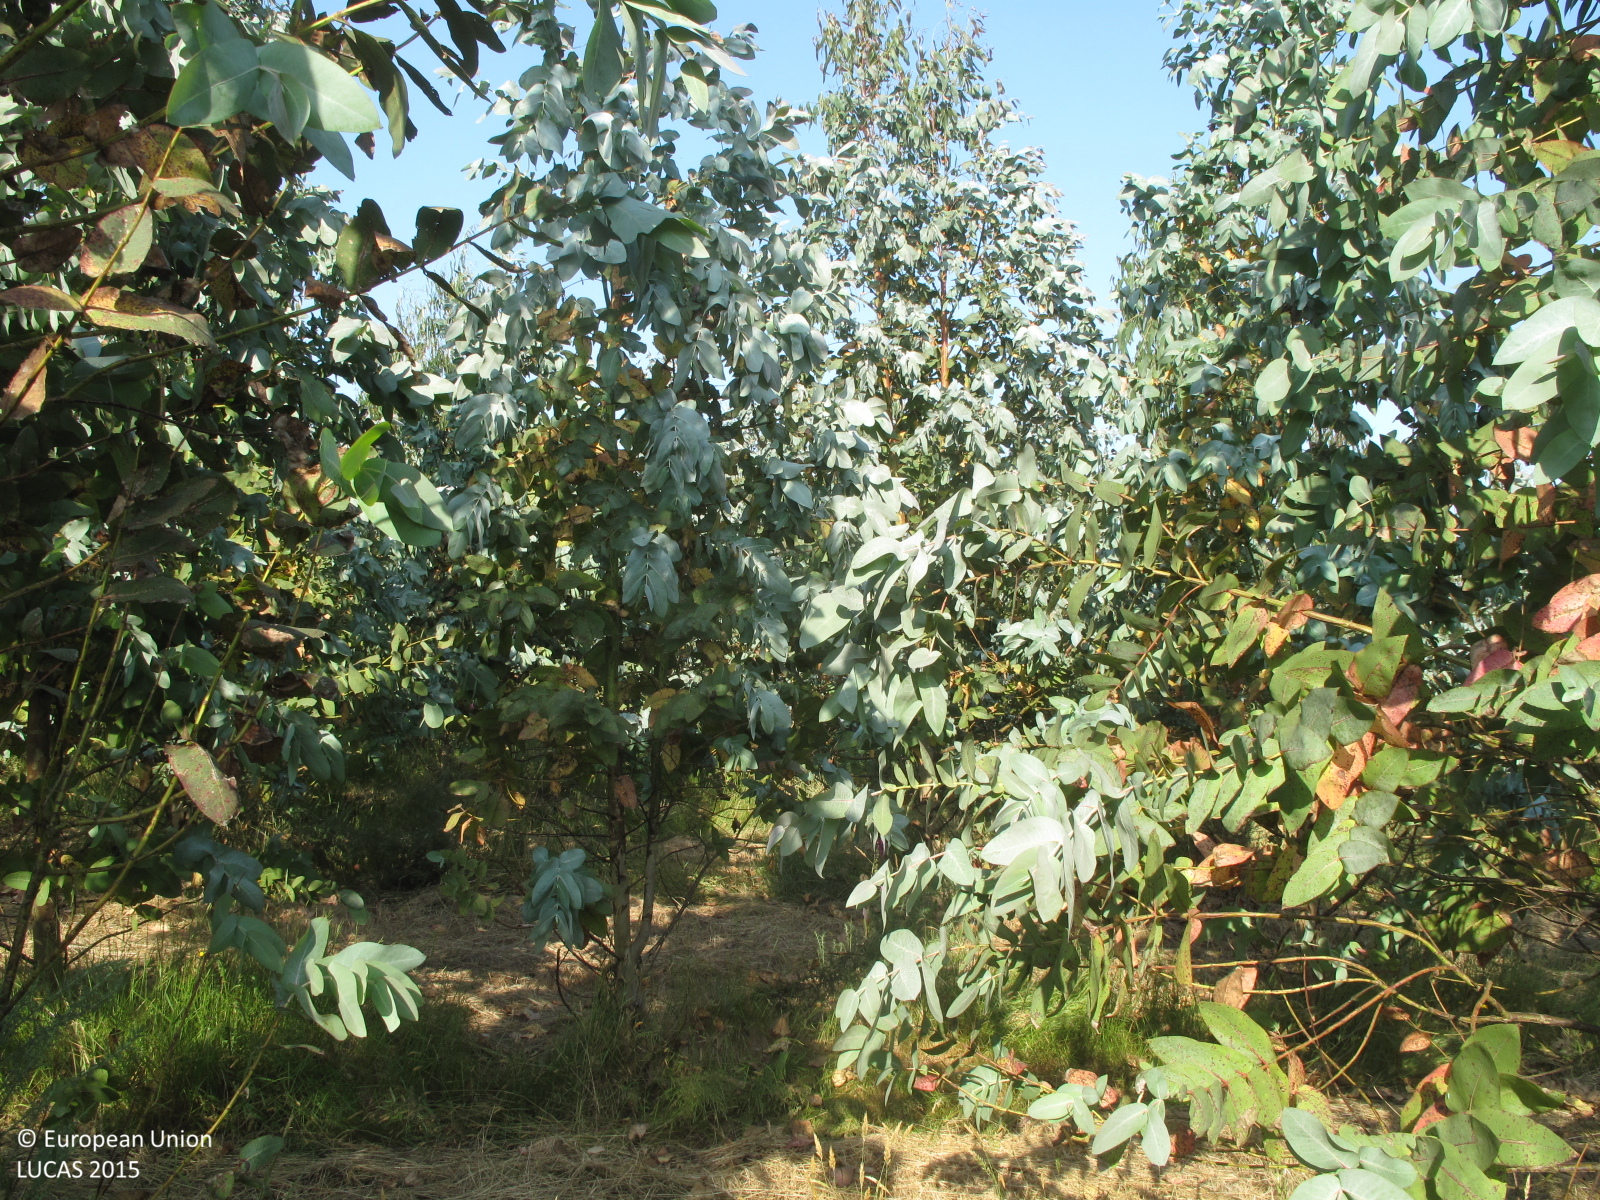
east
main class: Woodland
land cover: Broadleaved woodland
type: exotic forest
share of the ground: 50 - 75 %
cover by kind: broadleaved forest trees 50 %, herbaceous plants 50 %
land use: Forestry
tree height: < 5 m
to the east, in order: Broadleaved woodland; Fences; Broadleaved woodland
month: June
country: ES
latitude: 43.0504
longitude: -7.9264
